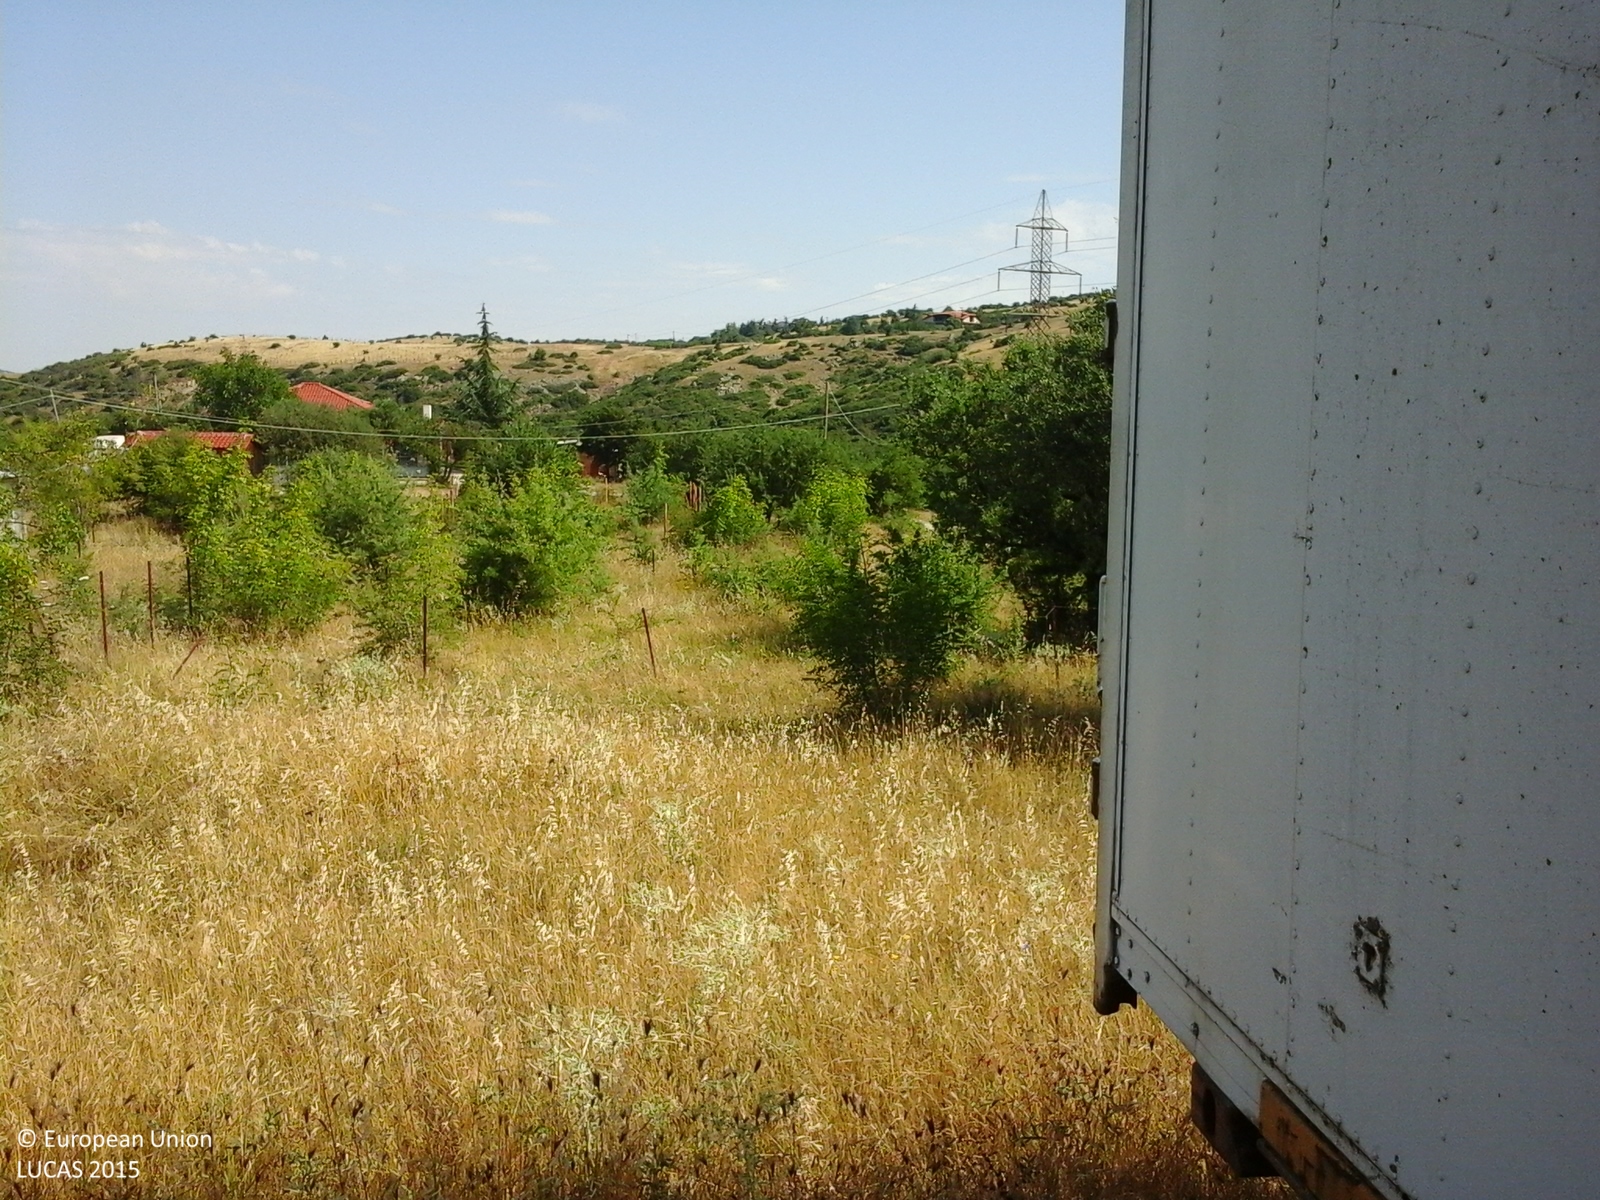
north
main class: Grassland
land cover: Spontaneously vegetated surfaces
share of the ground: > 75 %
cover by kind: herbaceous plants 100 %
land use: Semi-natural and natural areas not in use
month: June
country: GR
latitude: 40.6807
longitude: 22.9874
